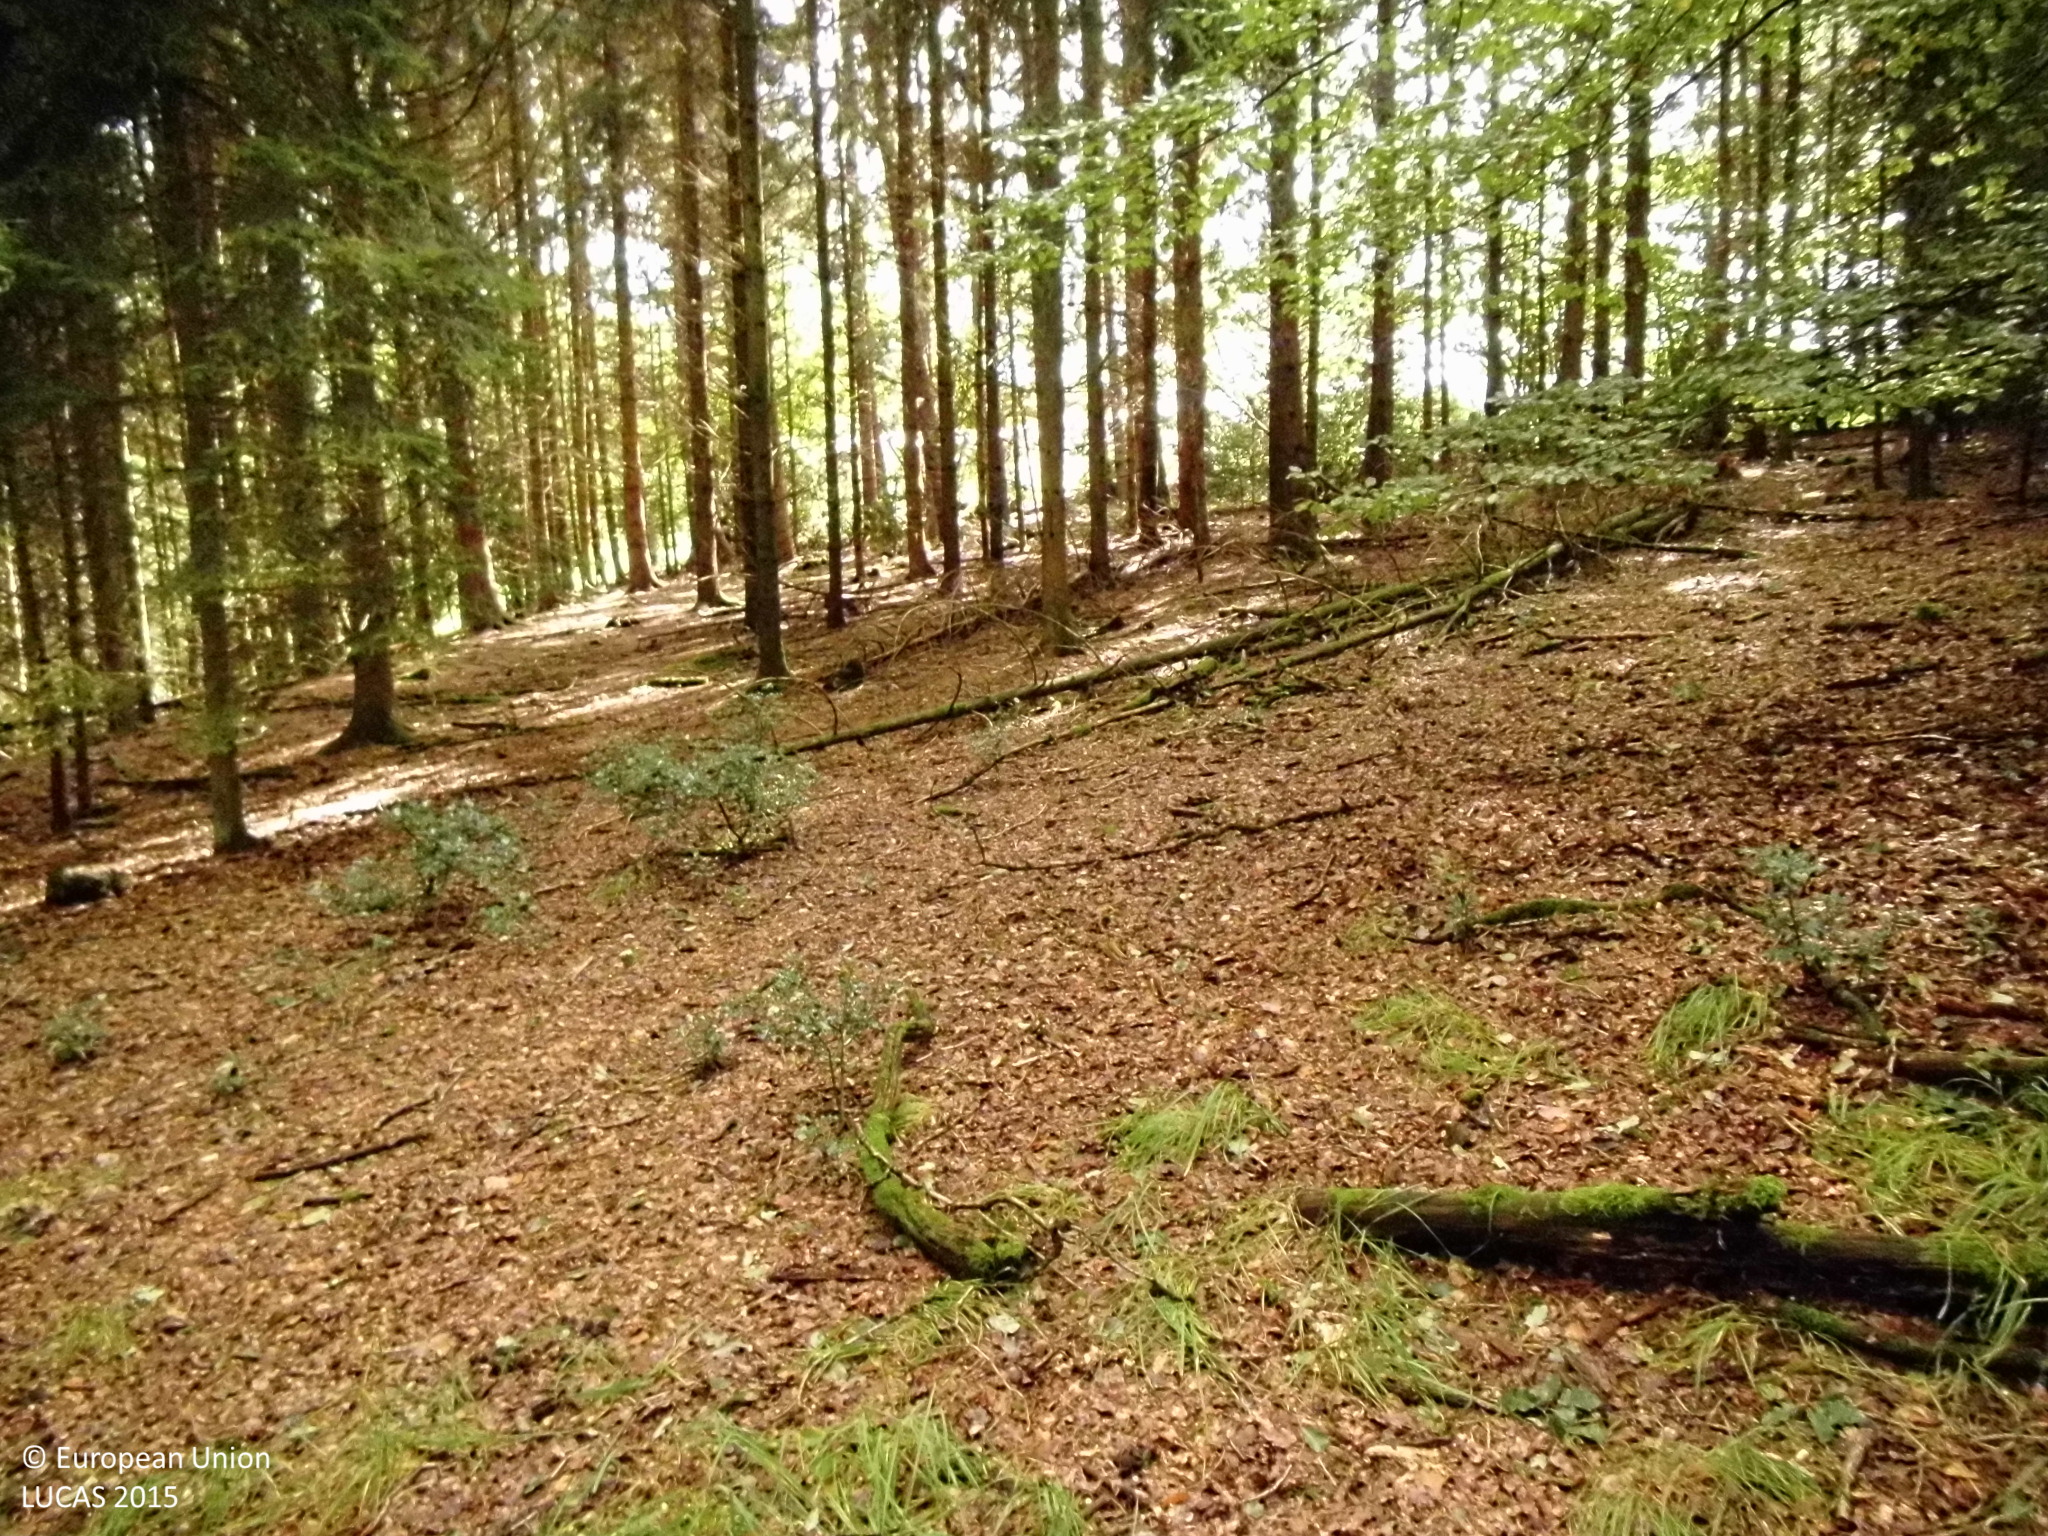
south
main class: Woodland
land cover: Broadleaved woodland
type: mesophytic deciduous forest
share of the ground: > 75 %
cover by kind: broadleaved forest trees 100 %
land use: Forestry
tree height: > 5 m
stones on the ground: < 10 %
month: September
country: DE
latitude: 51.0923
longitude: 7.5016
